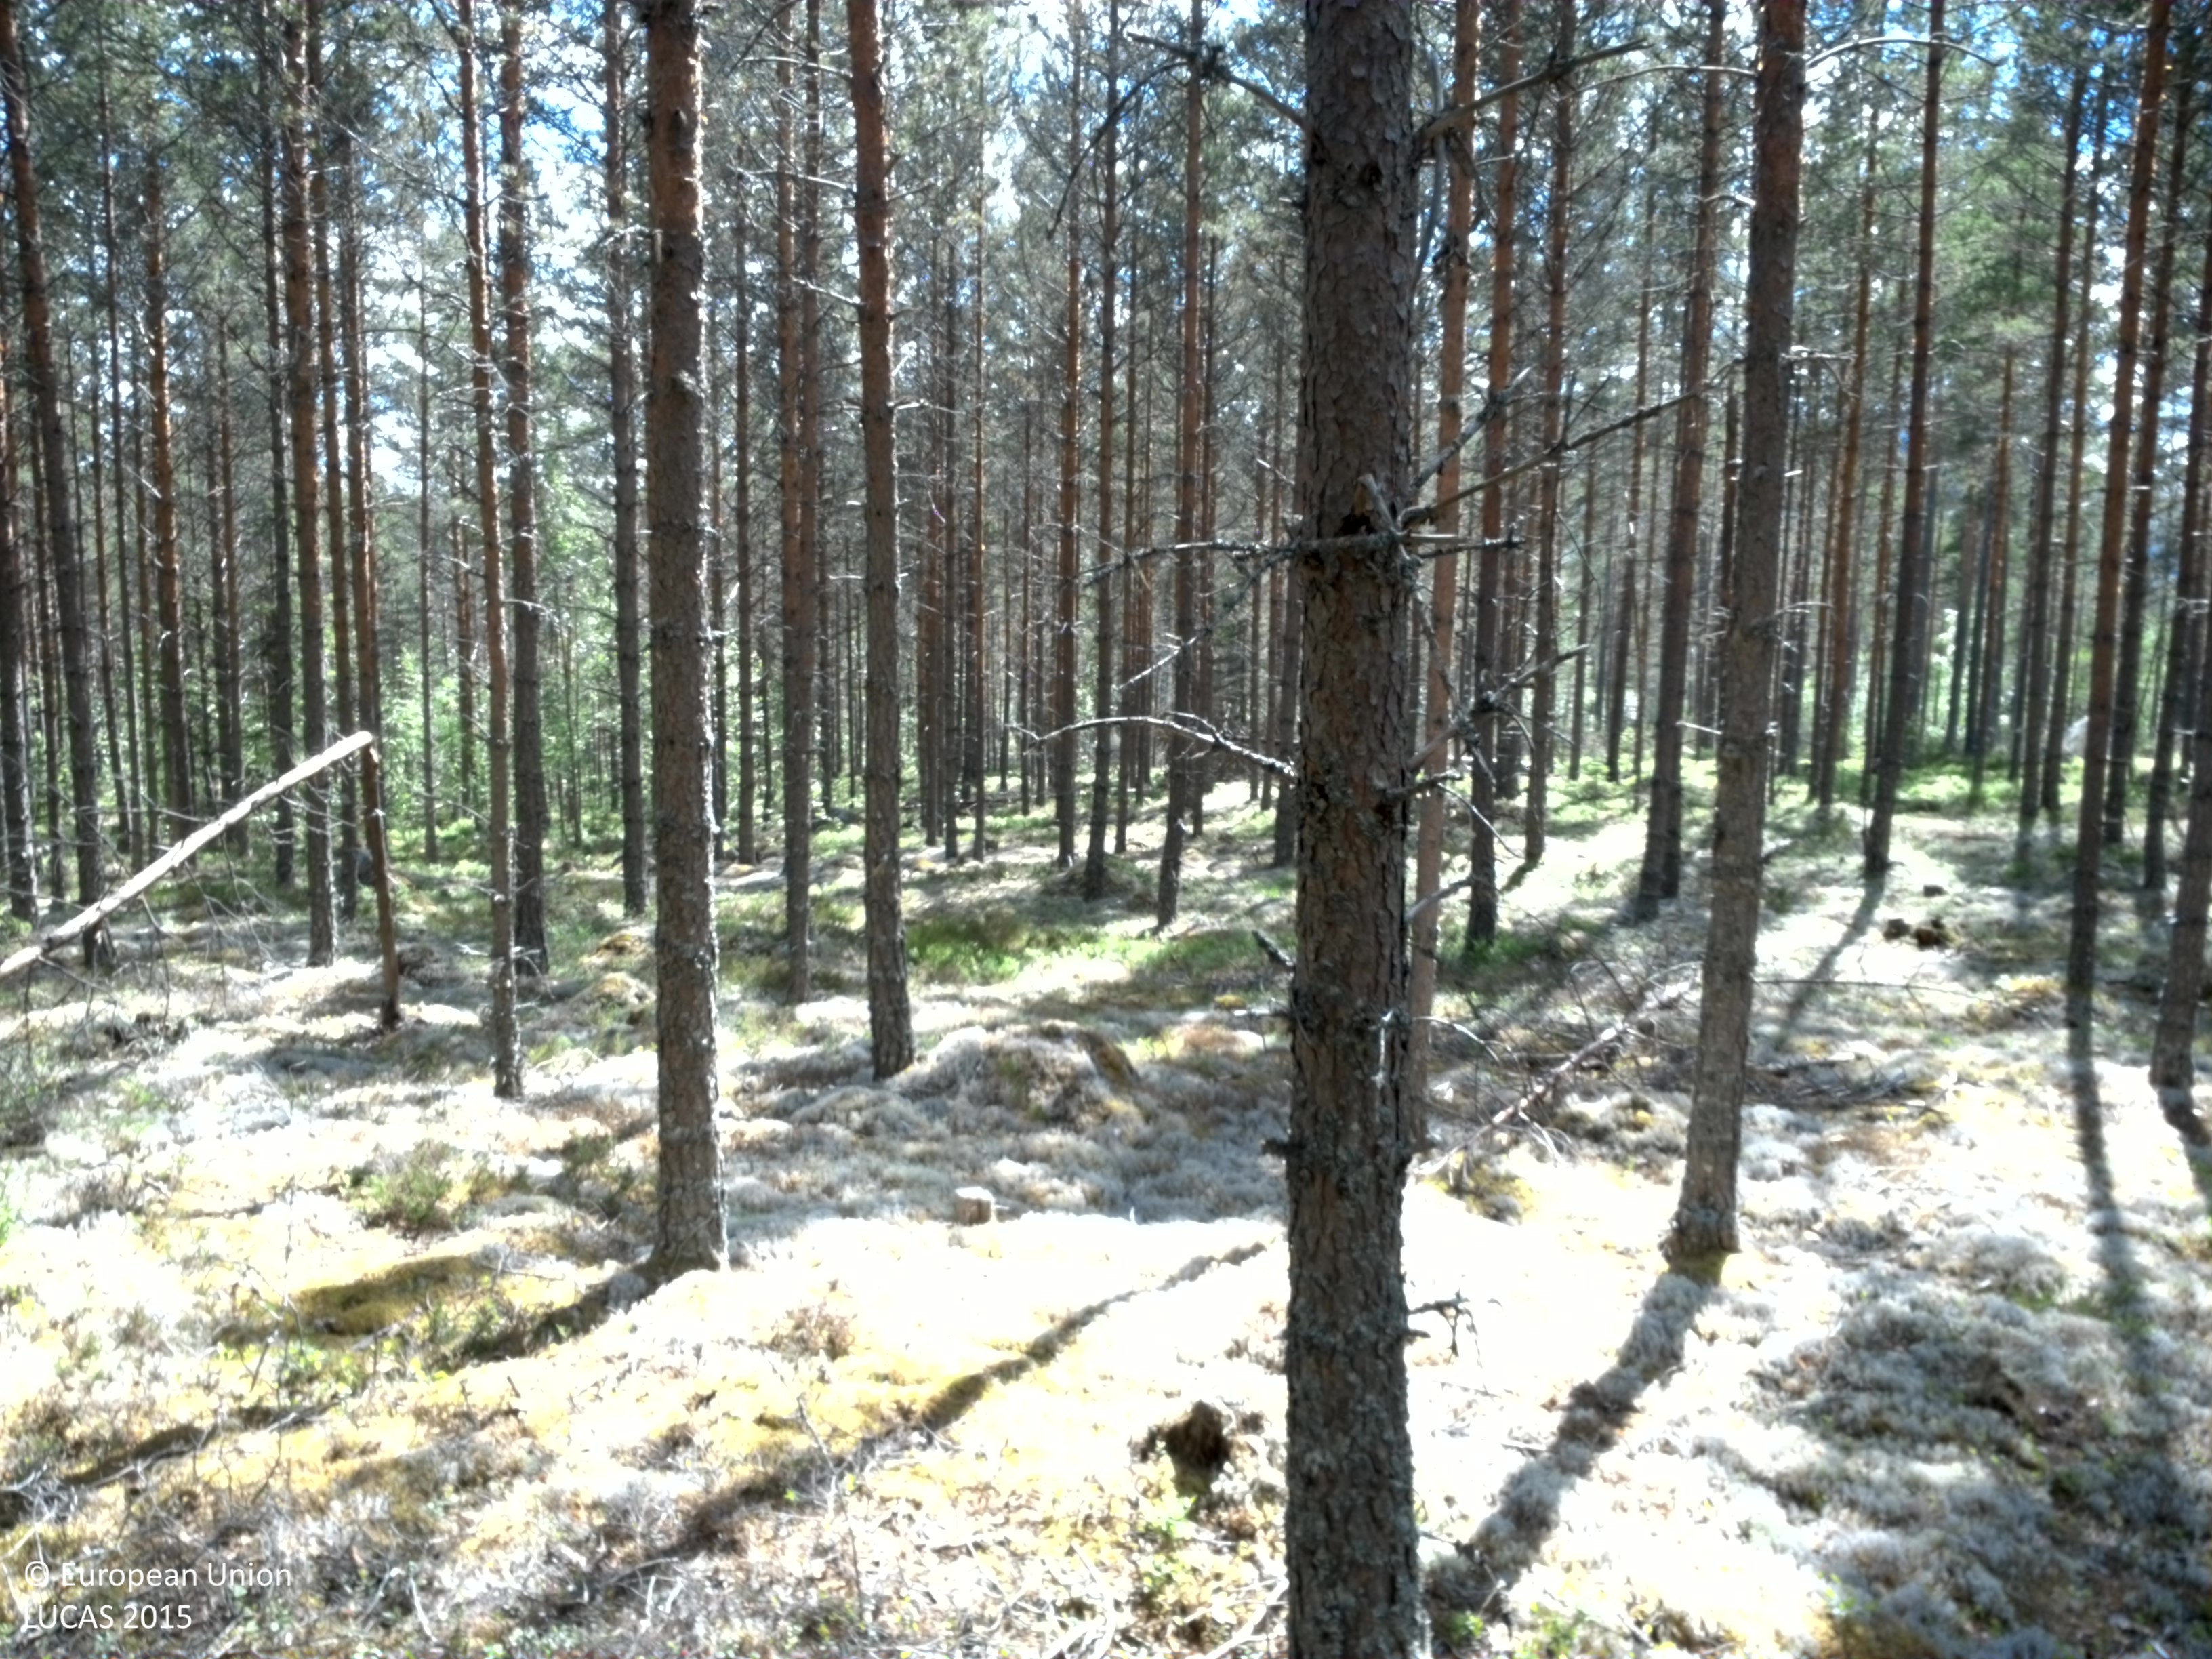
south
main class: Woodland
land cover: Pine dominated coniferous woodland
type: boreal forest
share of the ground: 25 - 50 %
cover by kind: coniferous forest trees 35 %, lichens and mosses 35 %, shrubs 30 %
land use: Forestry
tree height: > 5 m
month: June
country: SE
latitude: 60.6988
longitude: 12.5013
